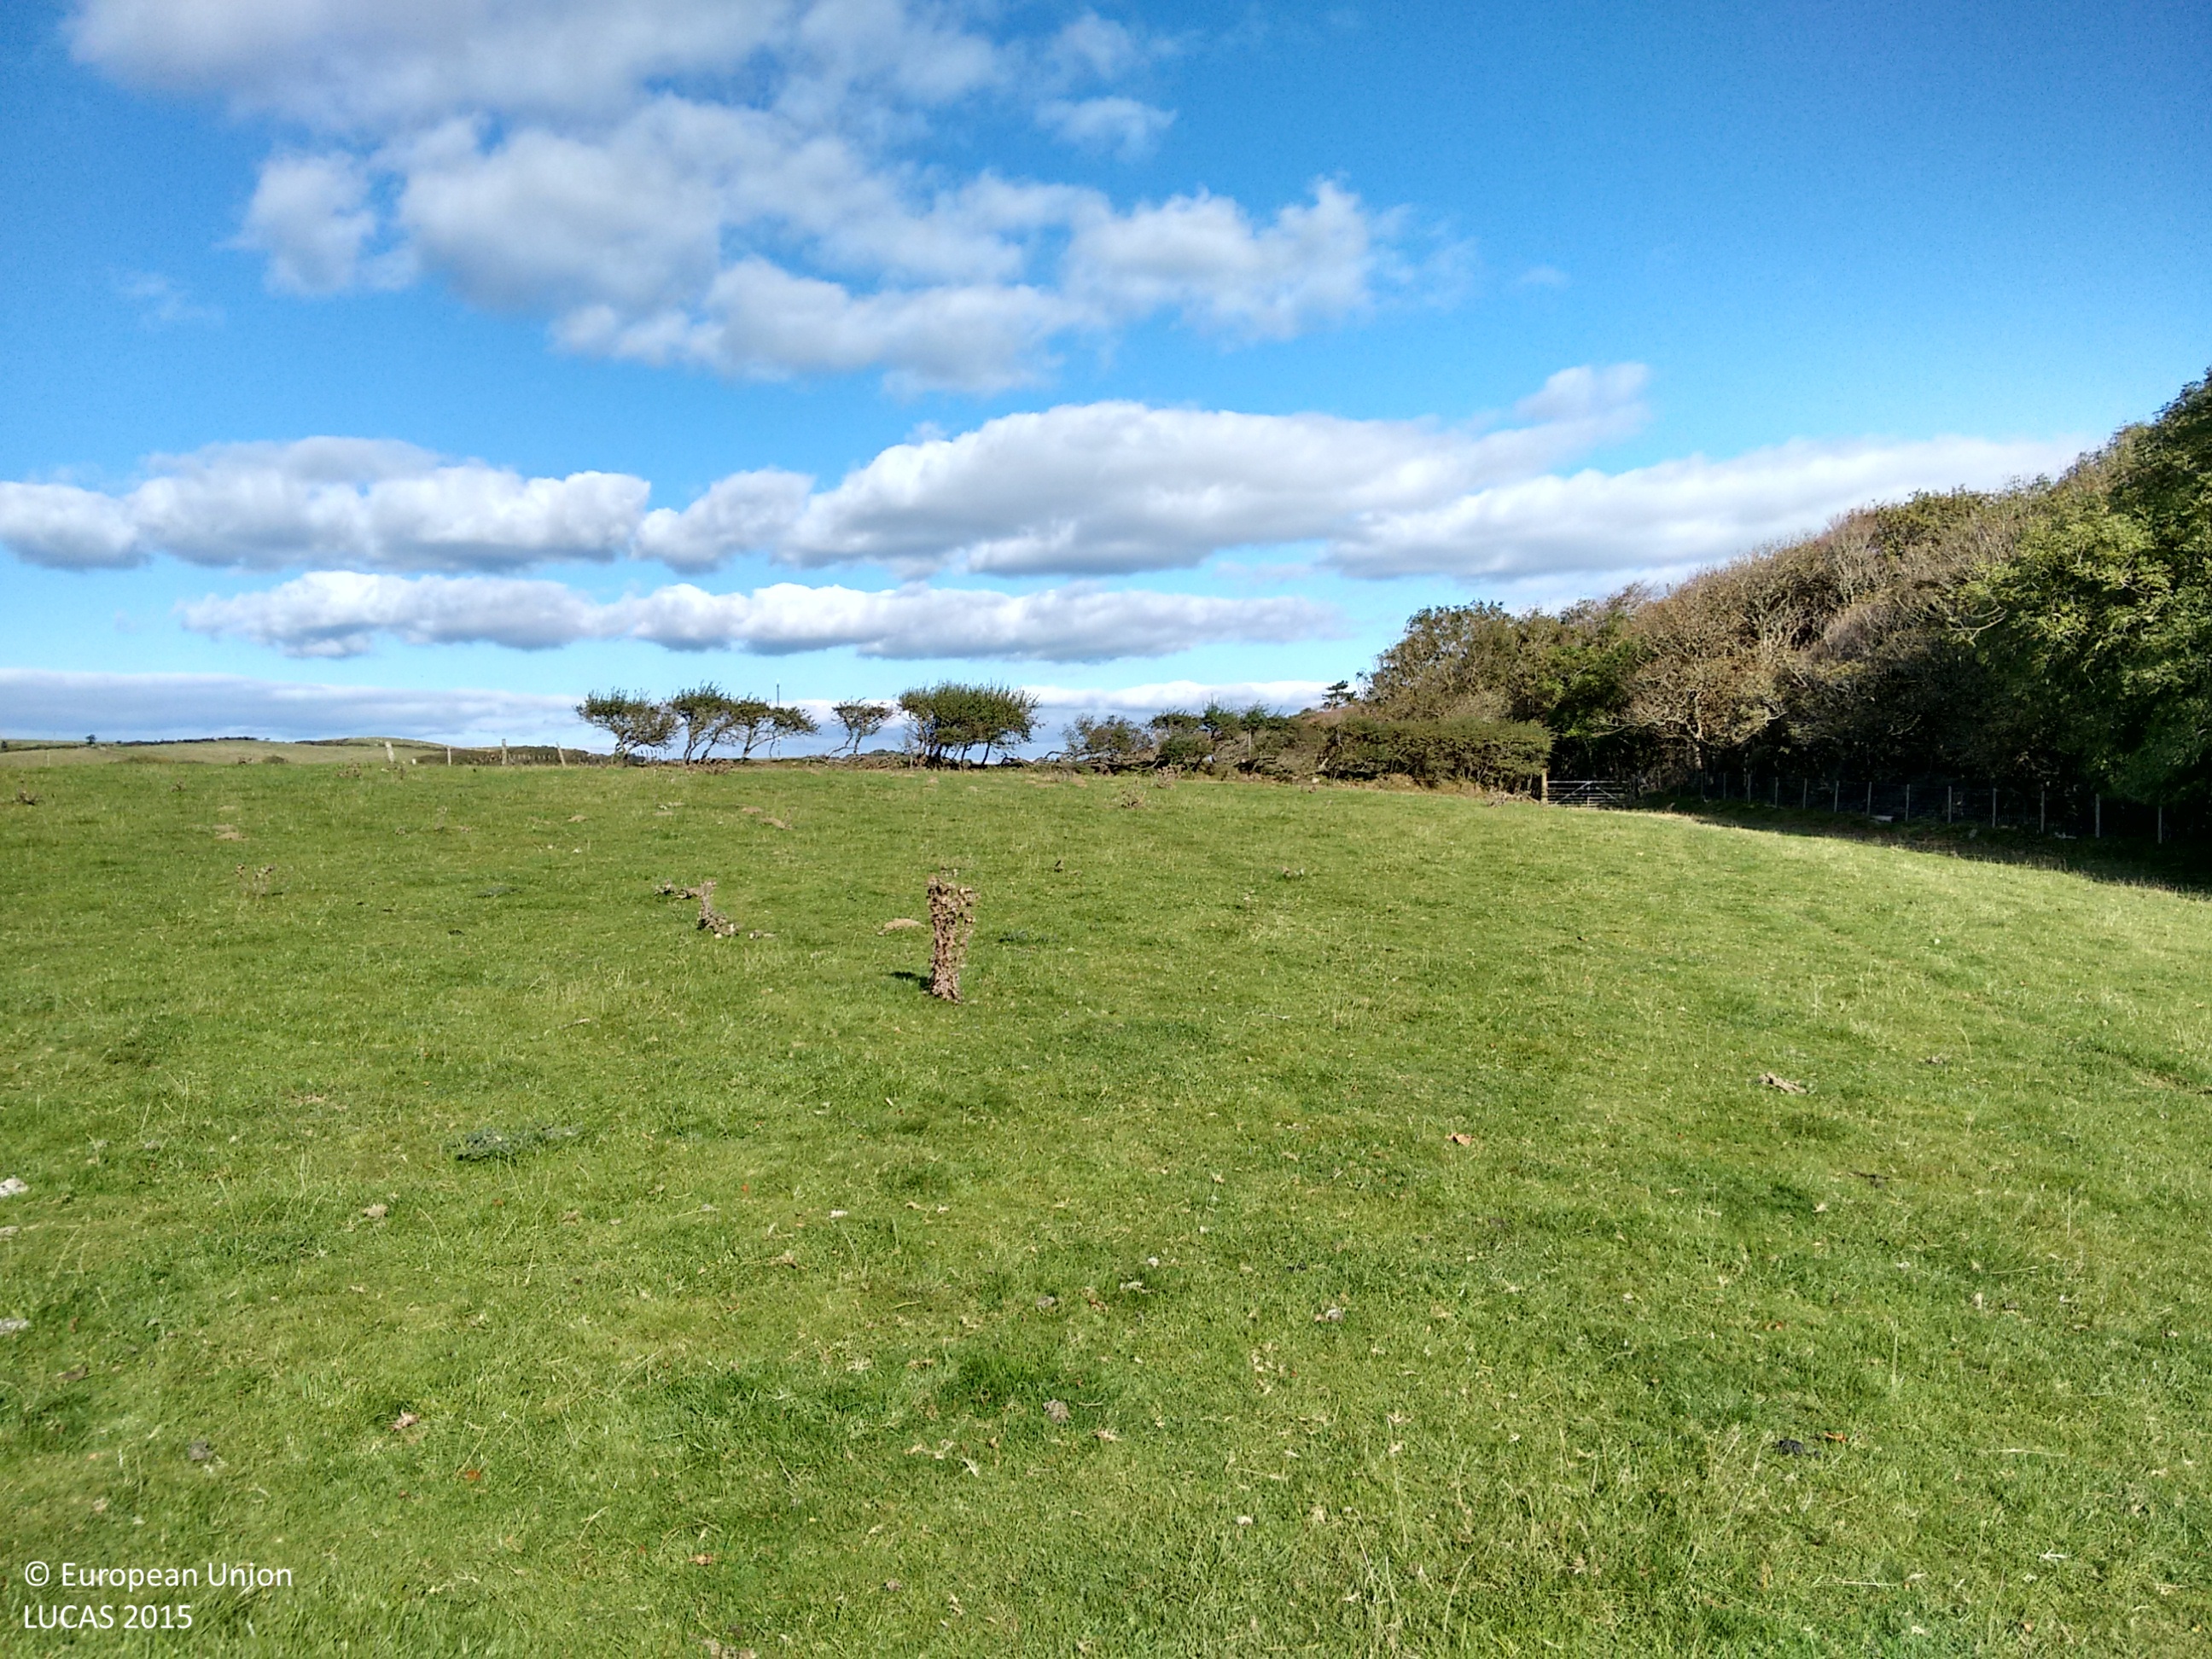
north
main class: Grassland
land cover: Grassland without tree/shrub cover
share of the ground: > 75 %
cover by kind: herbaceous plants 100 %
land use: Agriculture (excluding fallow land and kitchen gardens)
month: October
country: GB
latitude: 52.3324
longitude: -4.1115
